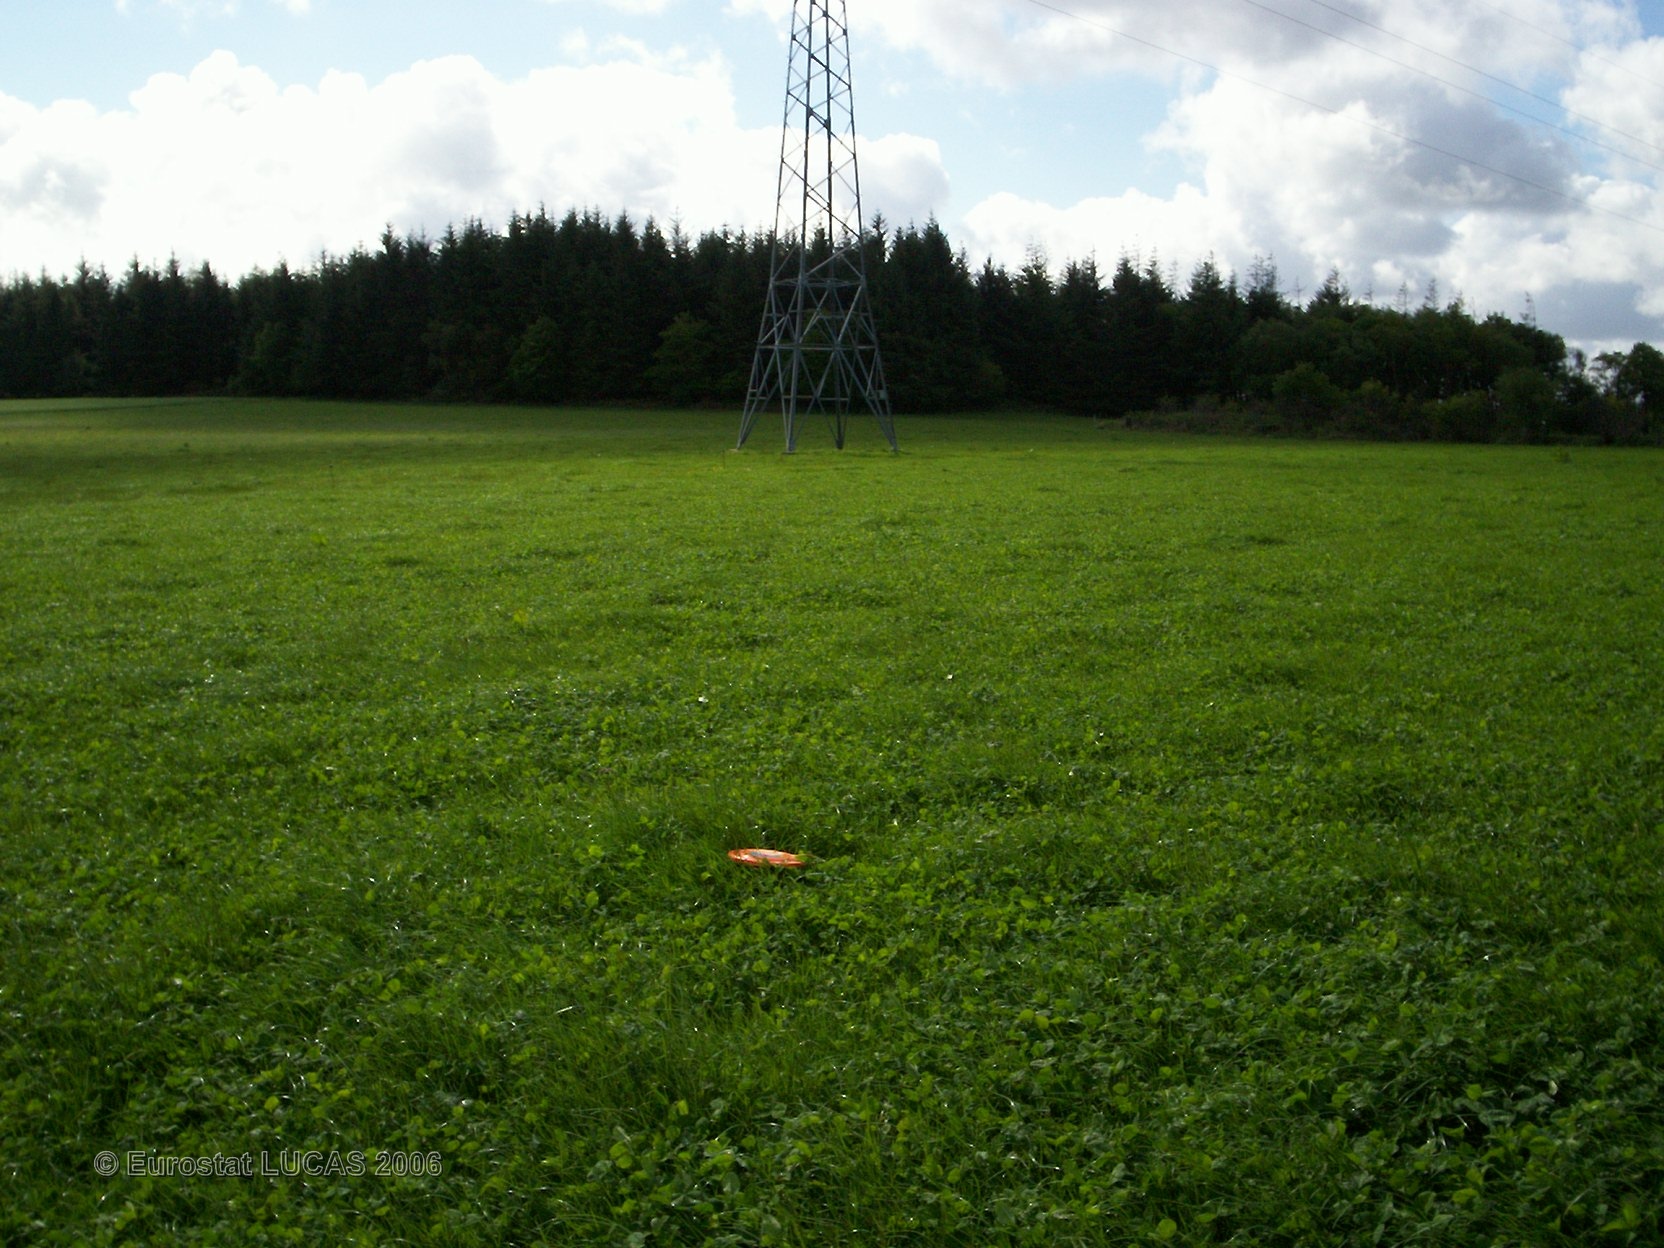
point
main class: Cropland
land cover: Clovers
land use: Agriculture (excluding fallow land and kitchen gardens)
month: May
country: FR
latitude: 48.2534
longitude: -2.9850
